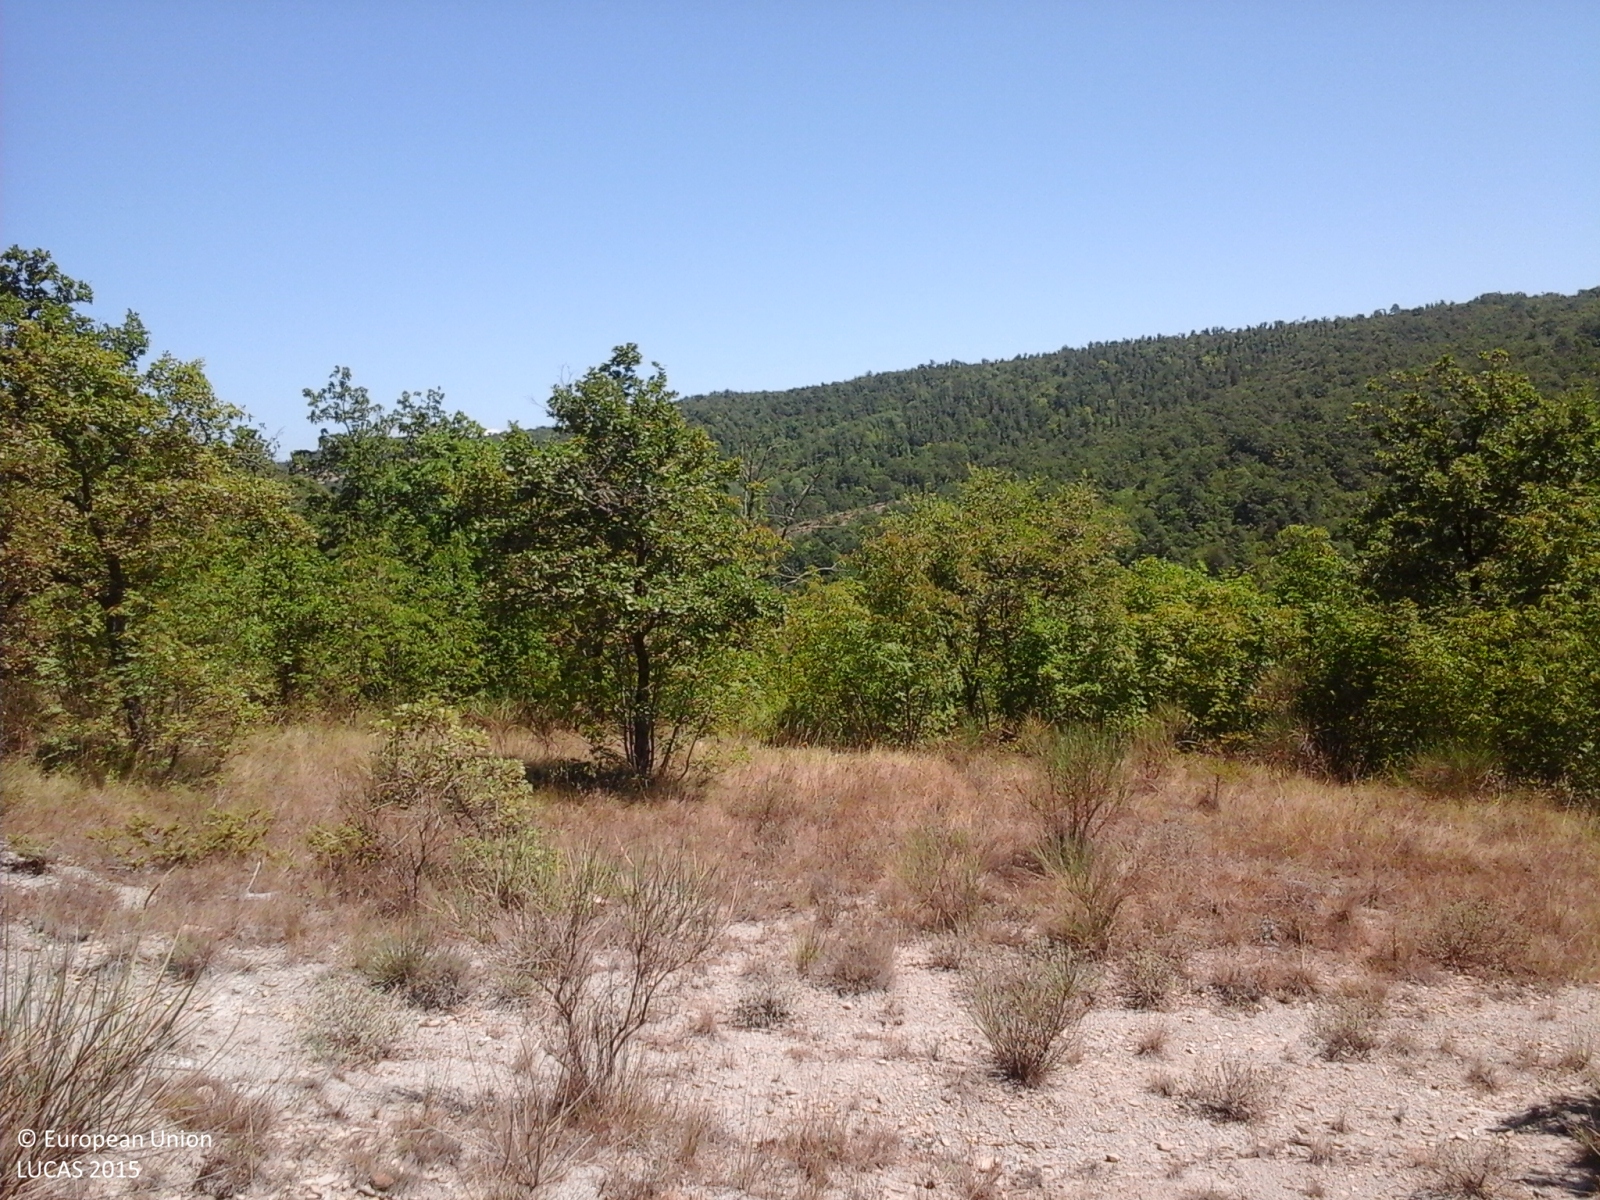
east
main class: Shrubland
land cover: Shrubland with sparse tree cover
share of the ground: > 75 %
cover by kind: shrubs 95 %, broadleaved forest trees 5 %
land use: Forestry
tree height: > 5 m
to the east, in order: Shrubland with sparse tree cover; Rocks and stones; Broadleaved woodland; Durum wheat; Paved roads, cycling and walking lanes; Durum wheat; Ditches and canals; Lucerne
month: August
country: IT
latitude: 43.4772
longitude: 12.2810
